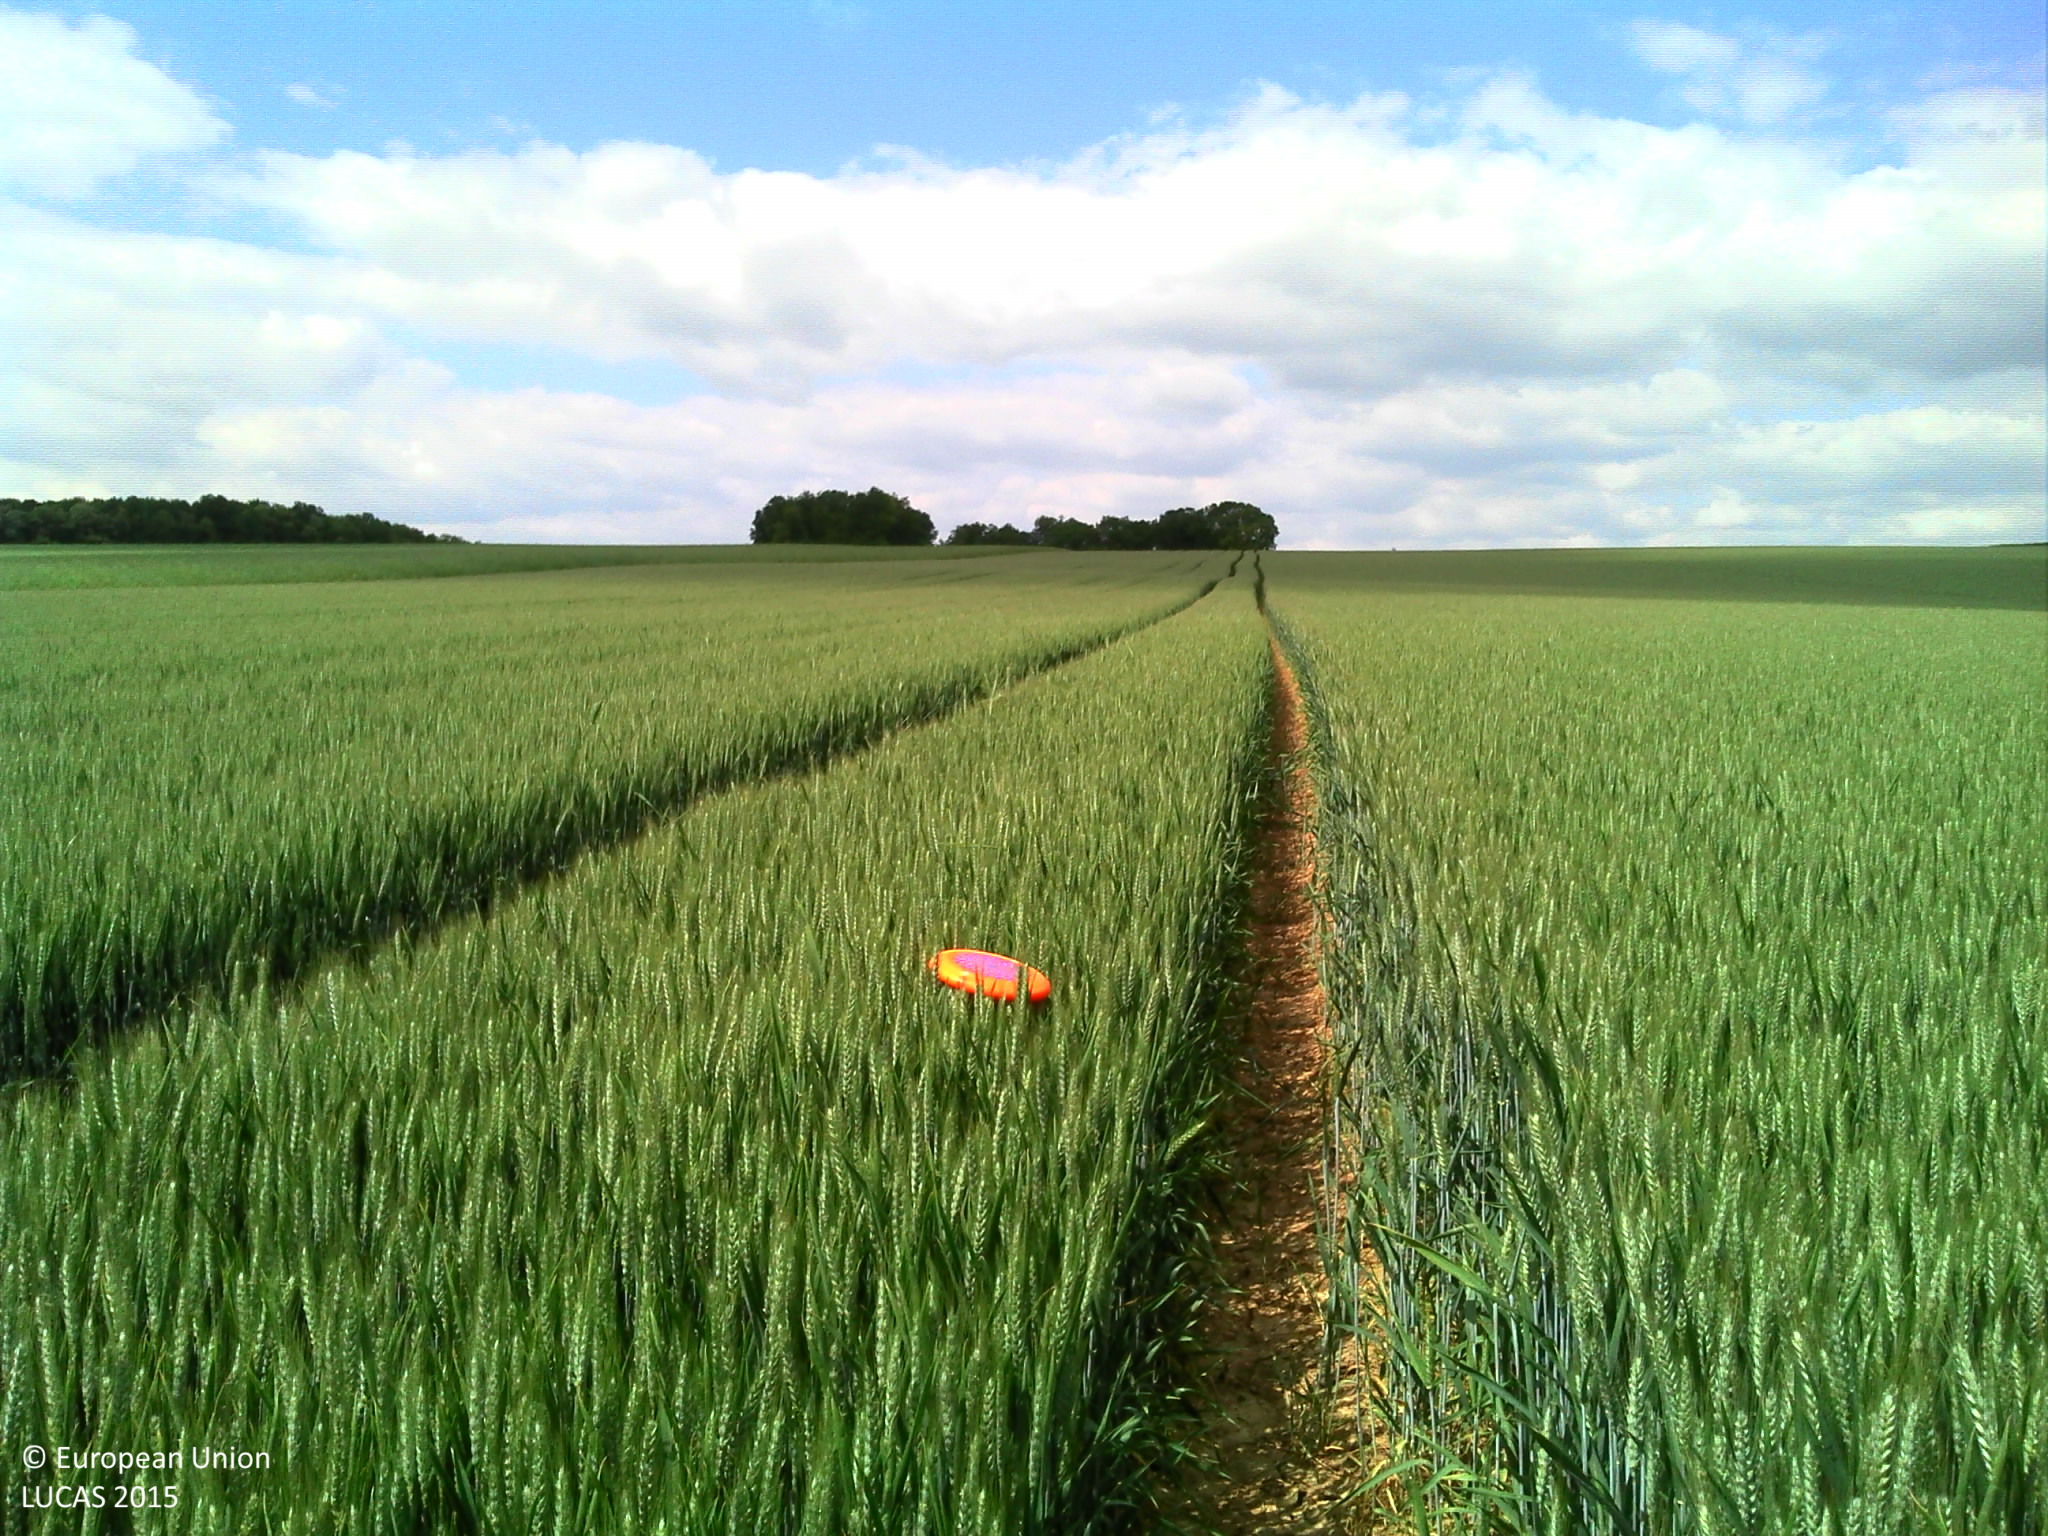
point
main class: Cropland
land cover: Common wheat
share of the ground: > 75 %
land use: Agriculture (excluding fallow land and kitchen gardens)
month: May
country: FR
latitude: 47.4502
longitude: 5.1596
